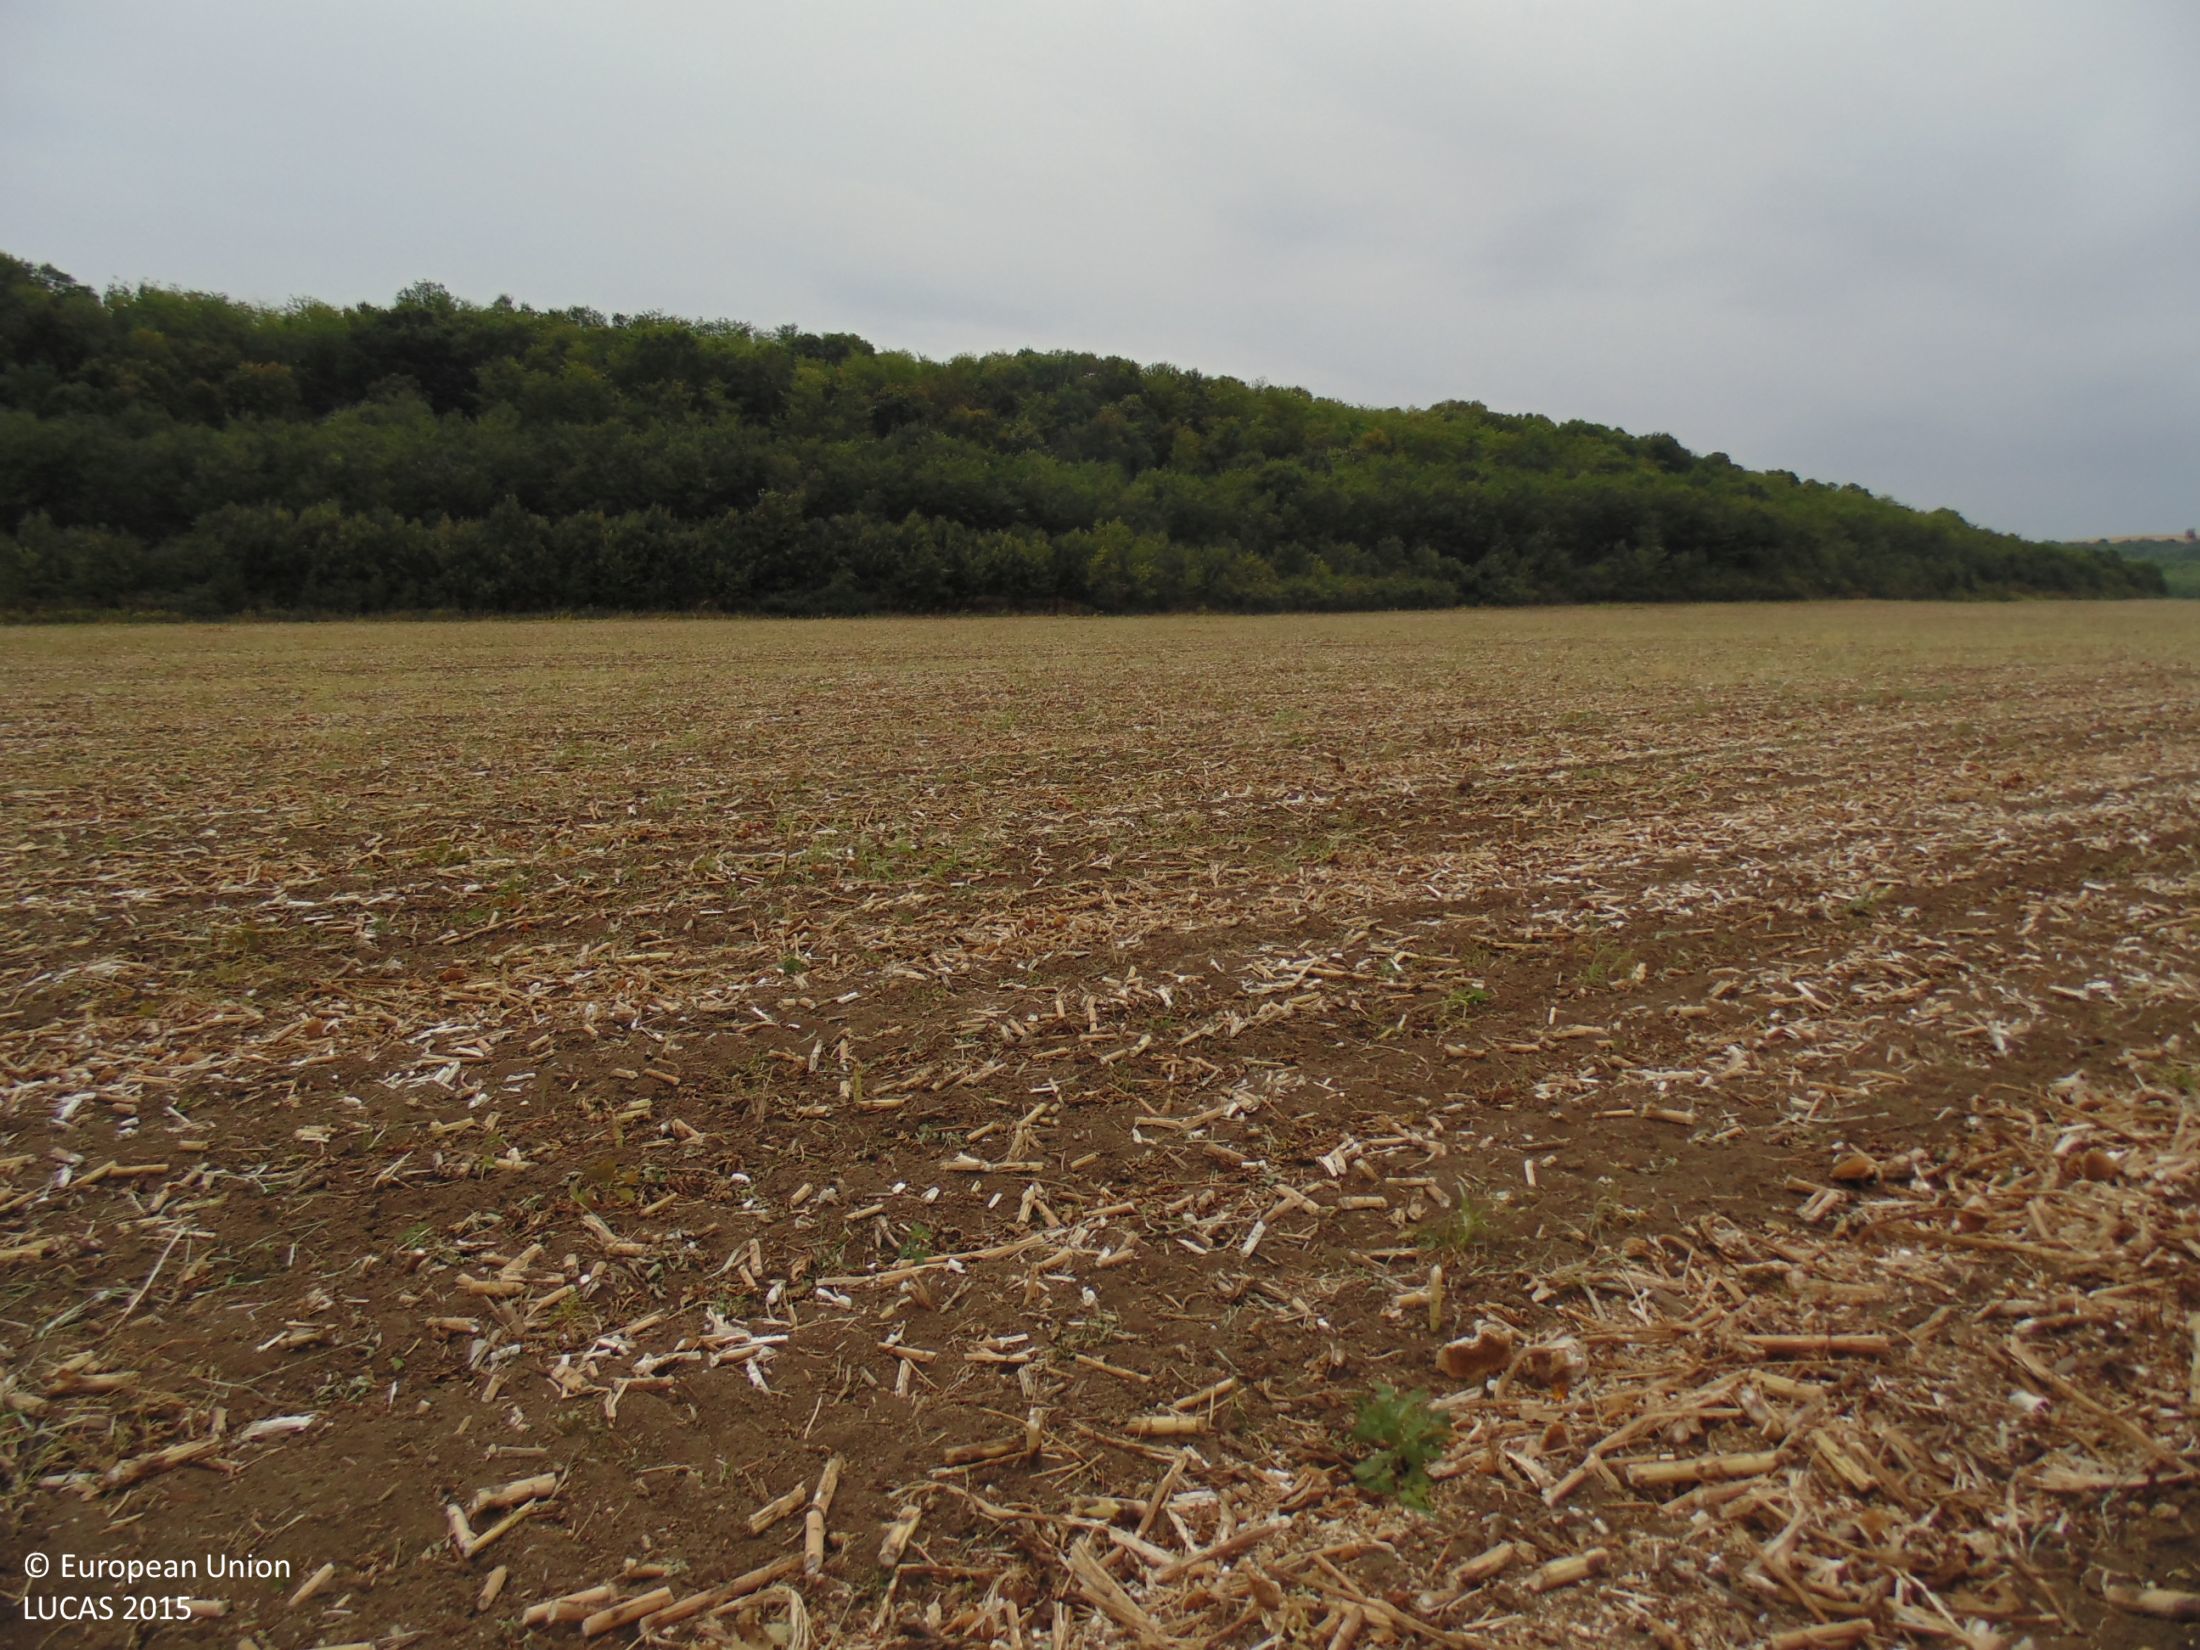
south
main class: Cropland
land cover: Sunflower
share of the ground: < 10 %
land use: Agriculture (excluding fallow land and kitchen gardens)
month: September
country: BG
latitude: 44.0327
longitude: 26.9293
